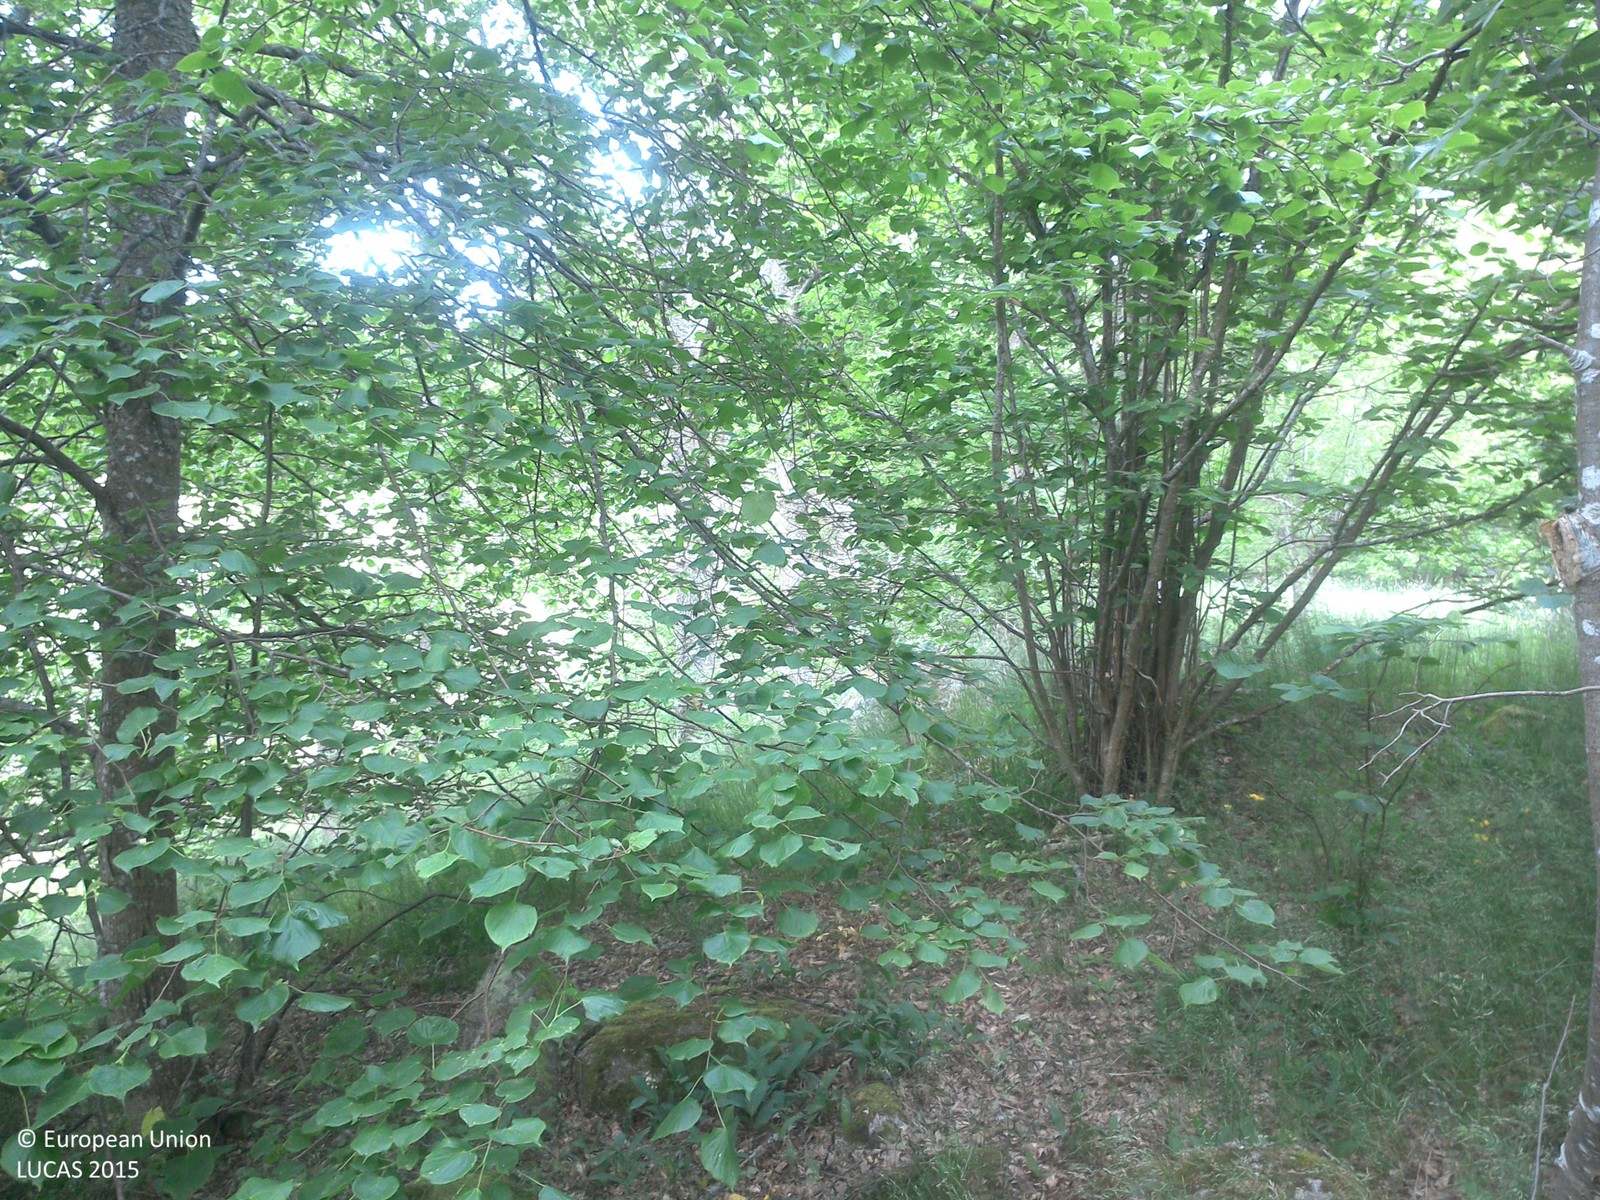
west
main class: Woodland
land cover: Broadleaved woodland
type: boreal forest
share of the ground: > 75 %
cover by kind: broadleaved forest trees 75 %, herbaceous plants 25 %
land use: Forestry
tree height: > 5 m
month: June
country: SE
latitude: 58.1519
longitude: 15.7215
